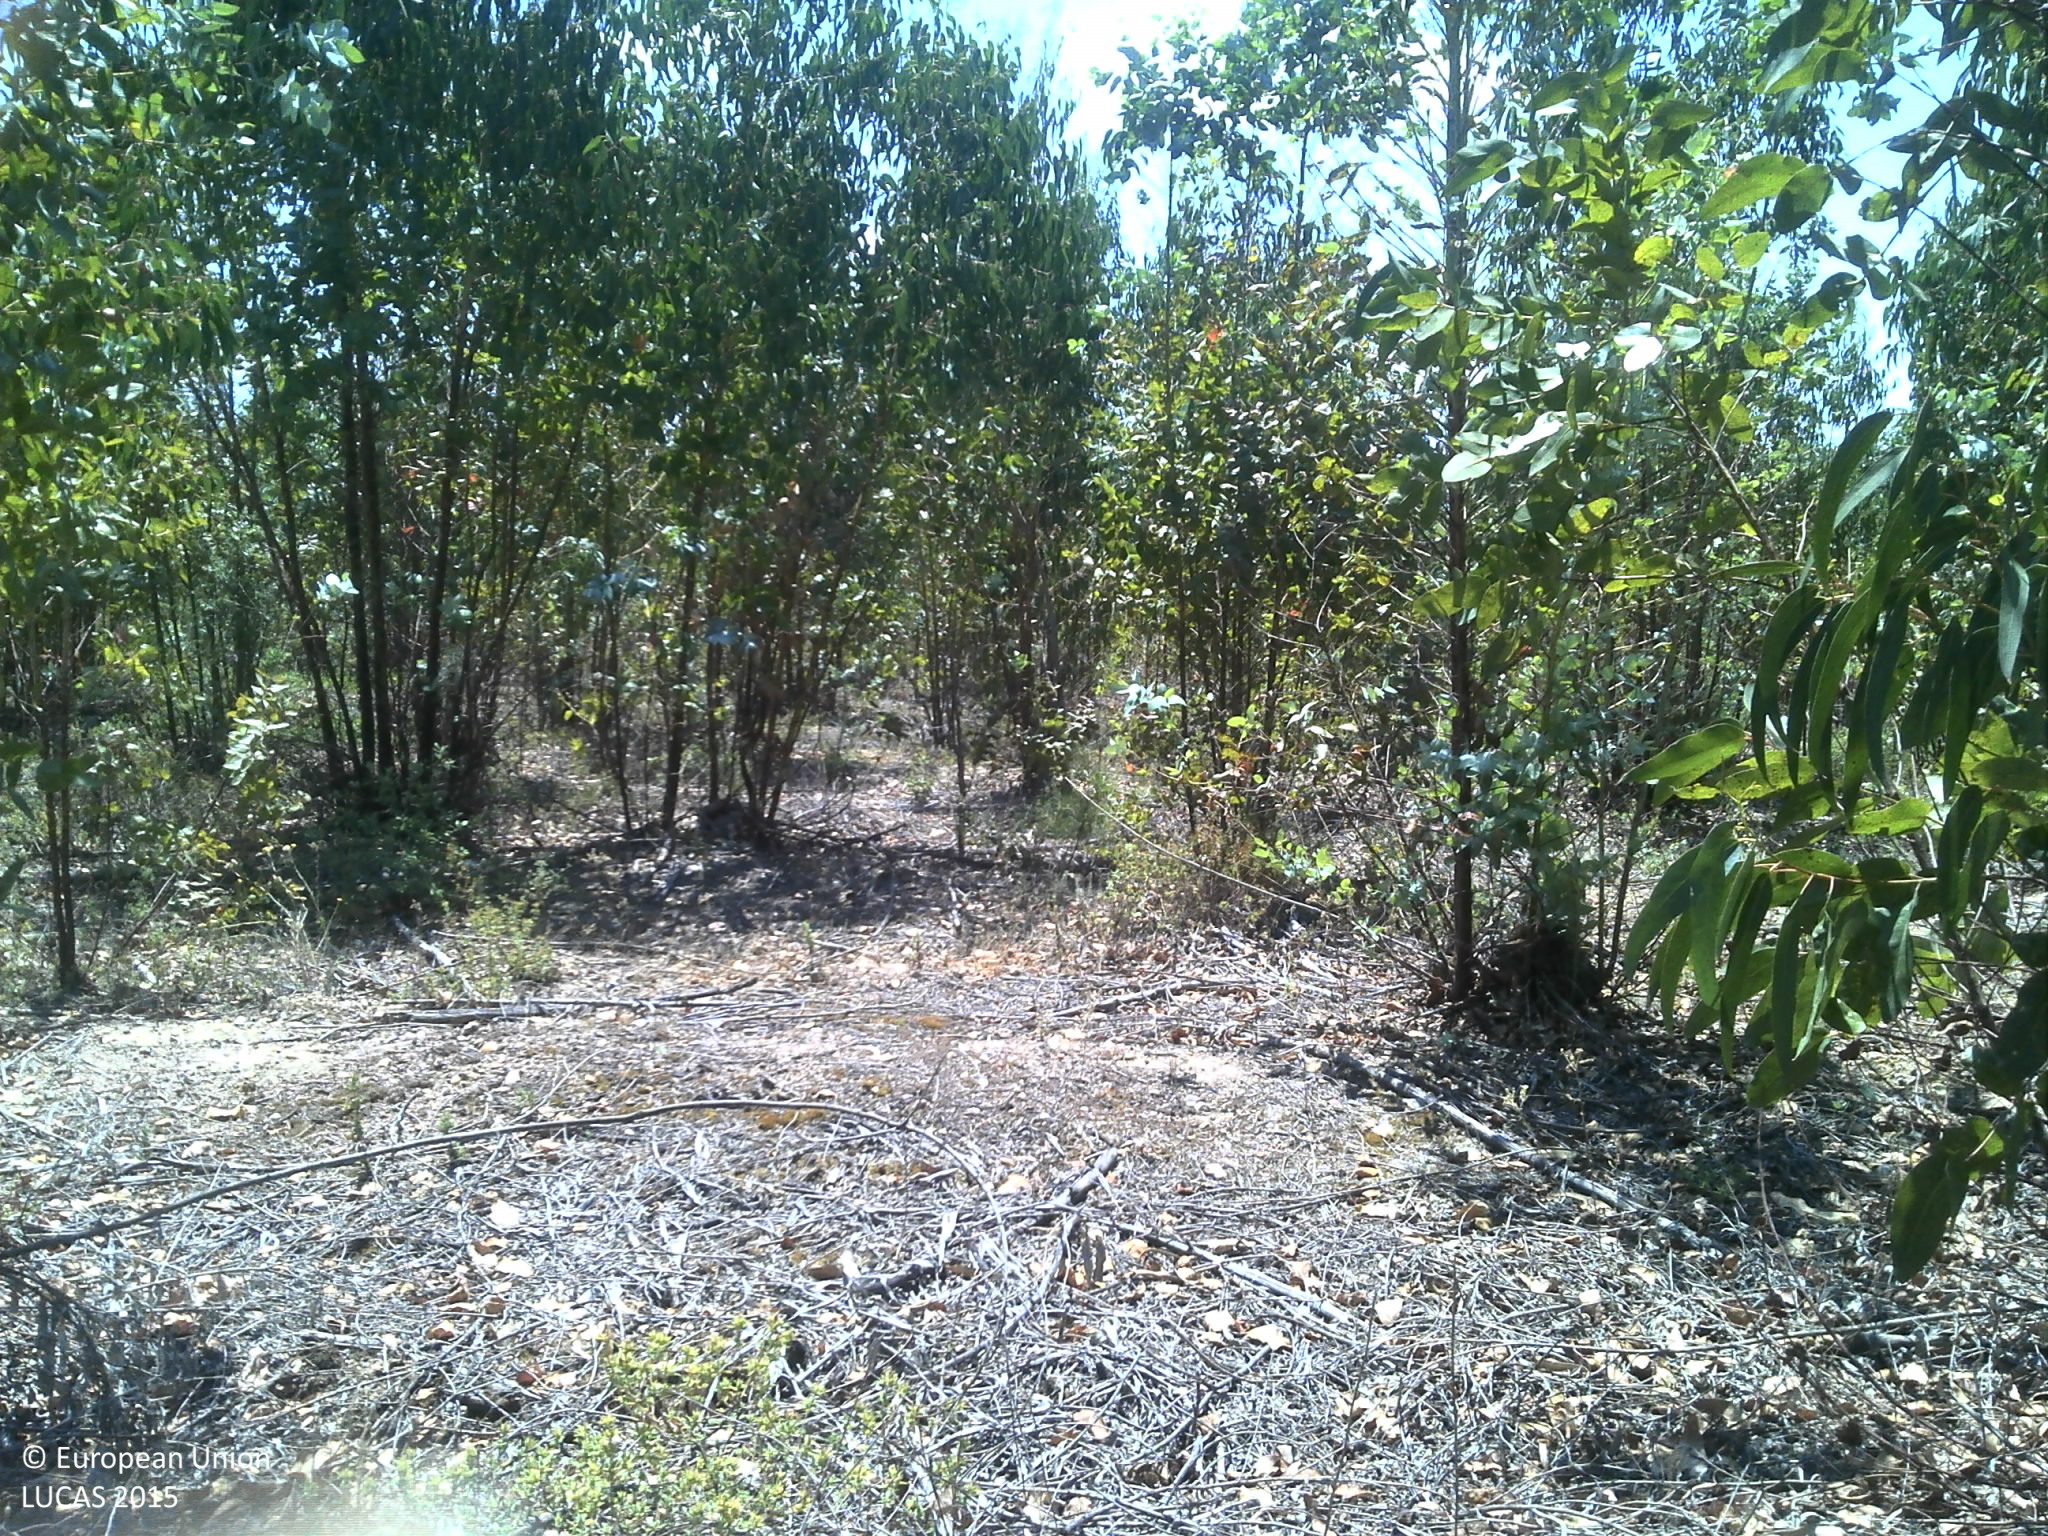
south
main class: Woodland
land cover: Broadleaved woodland
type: exotic forest
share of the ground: 50 - 75 %
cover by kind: broadleaved forest trees 75 %, shrubs 15 %, unconsolidated bare surface 10 %
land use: Forestry
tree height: > 5 m
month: June
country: PT
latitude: 39.2878
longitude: -8.3001
